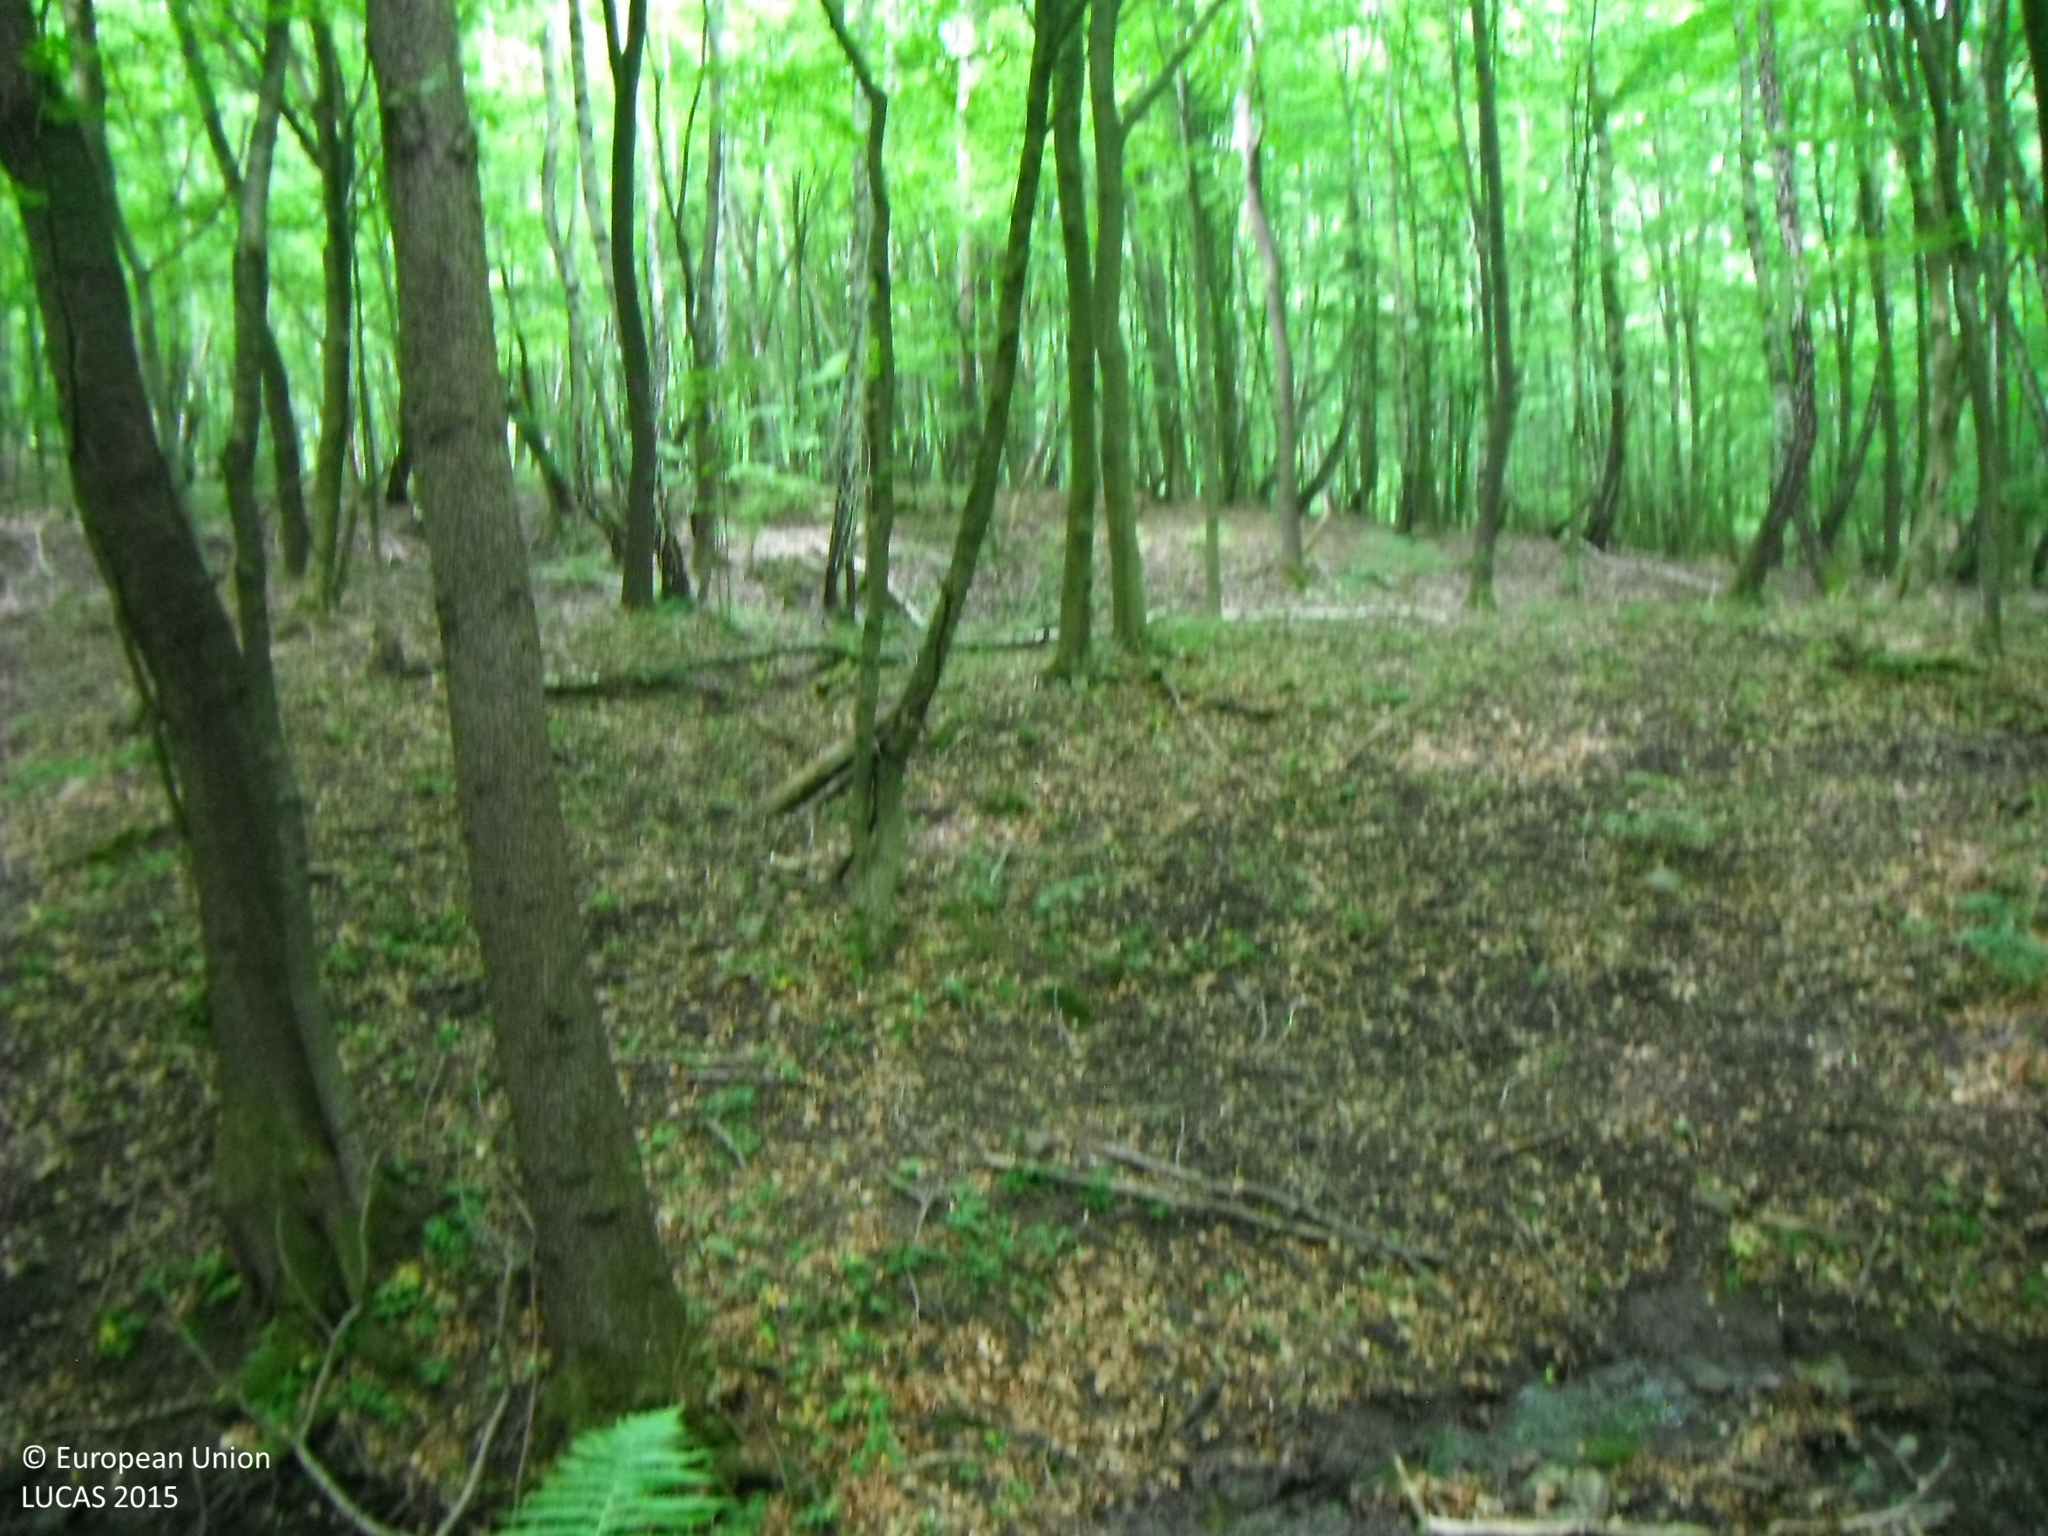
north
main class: Woodland
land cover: Broadleaved woodland
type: beech forest
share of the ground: > 75 %
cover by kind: broadleaved forest trees 100 %
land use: Forestry
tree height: > 5 m
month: June
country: SK
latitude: 48.8691
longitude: 21.5414
